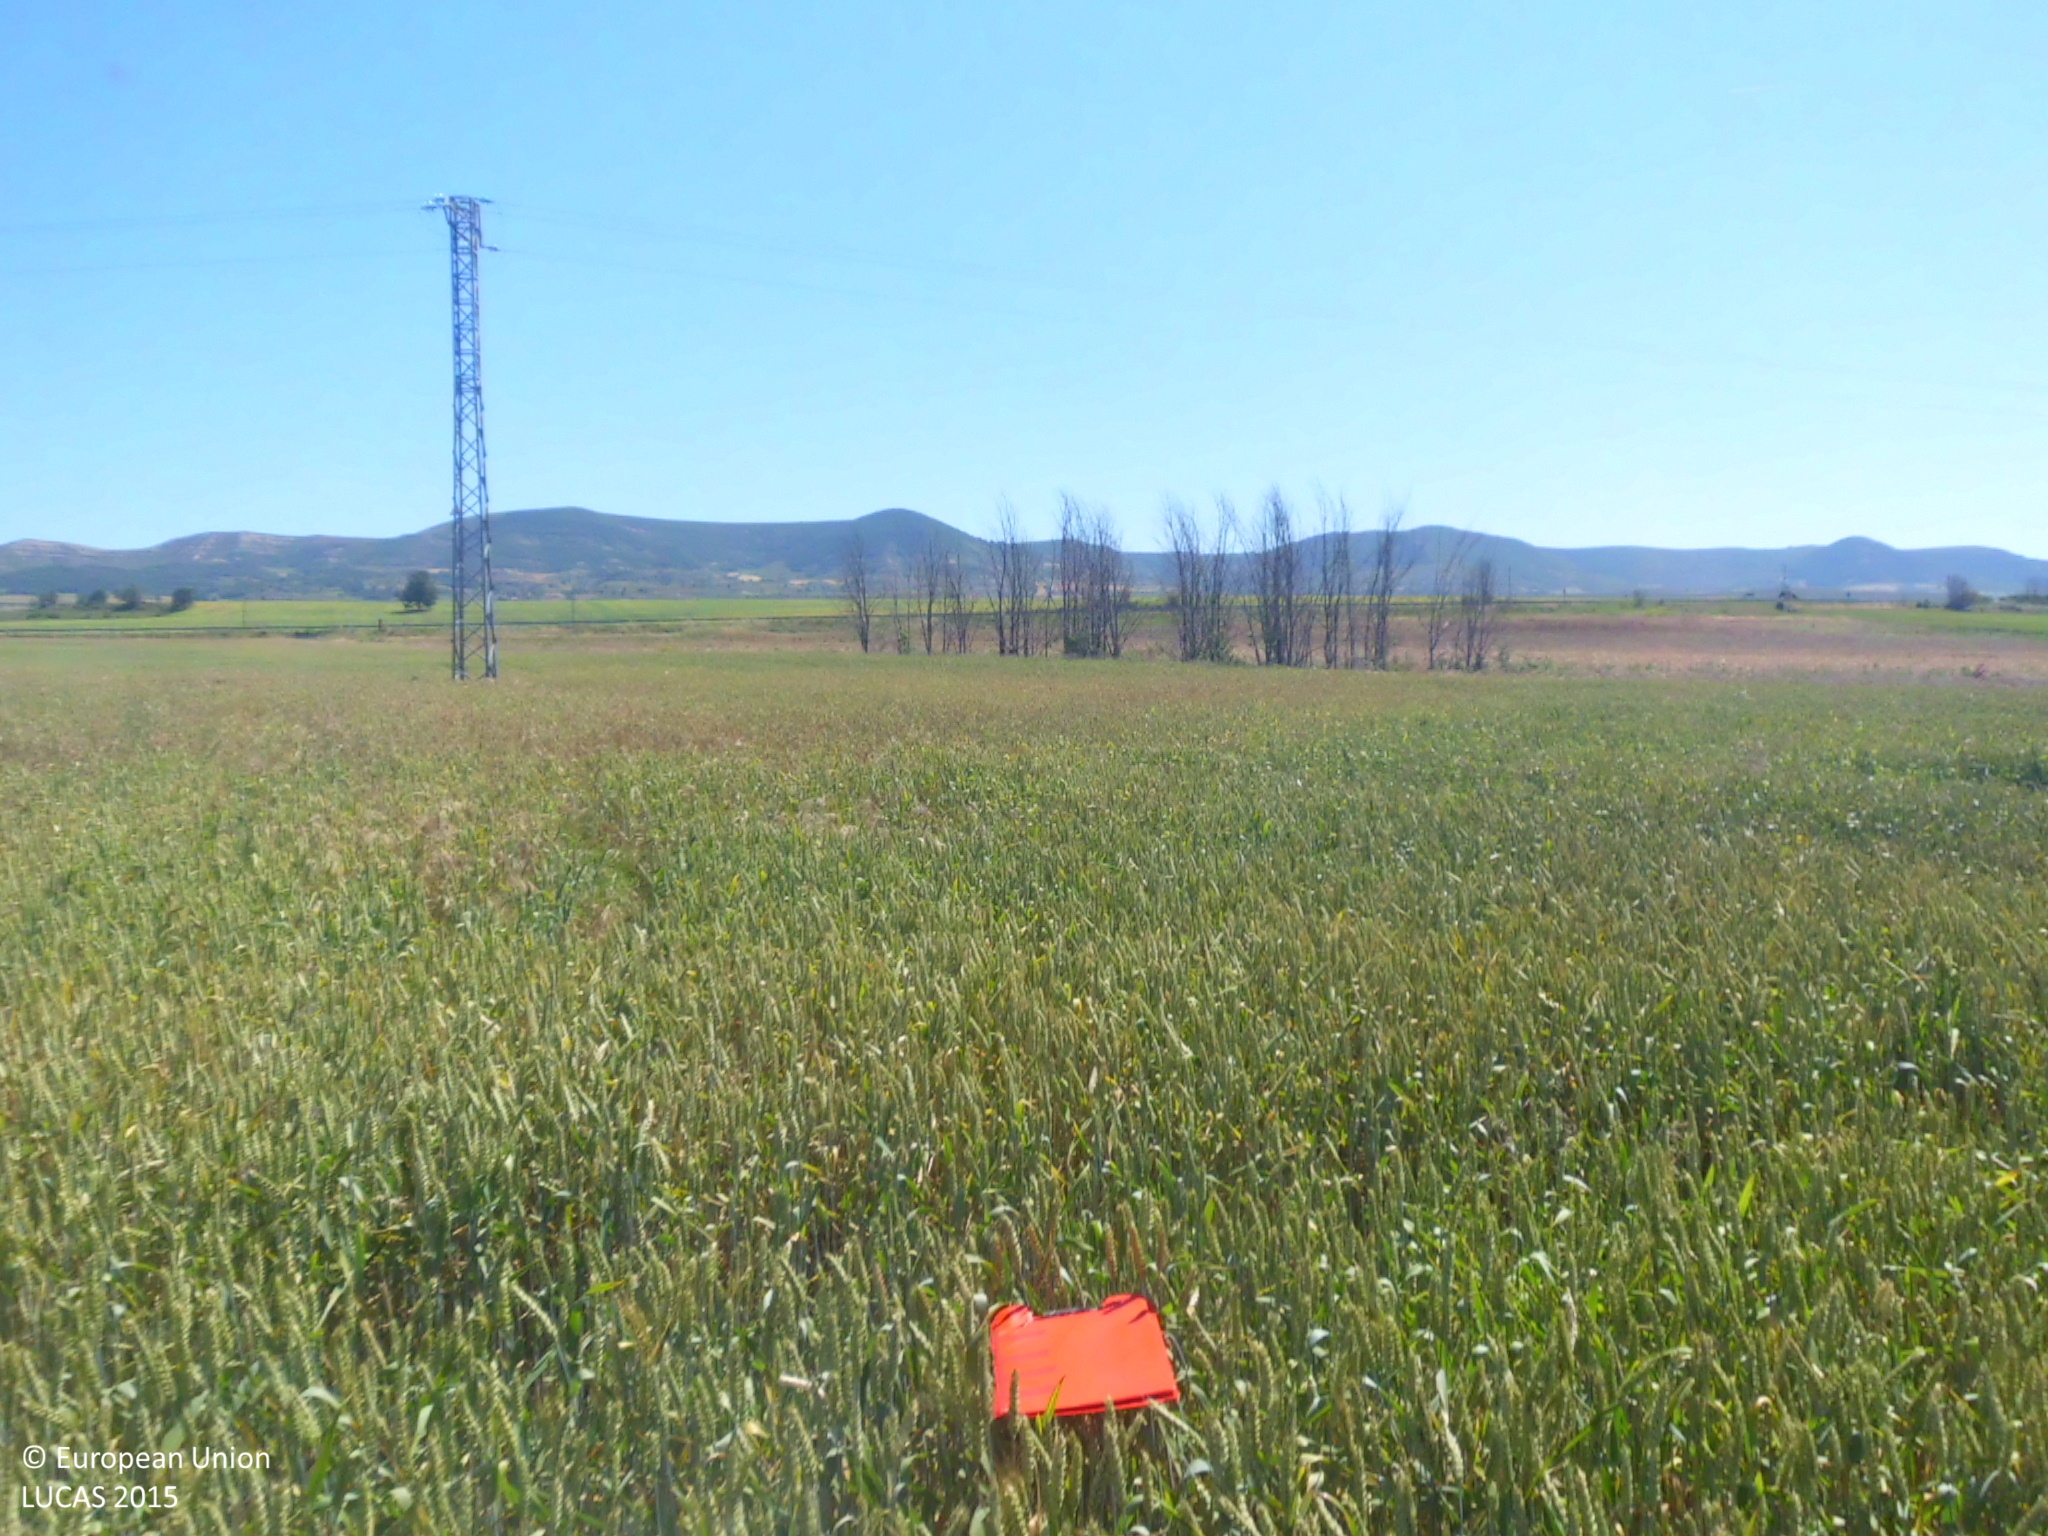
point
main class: Cropland
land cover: Common wheat
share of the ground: > 75 %
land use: Agriculture (excluding fallow land and kitchen gardens)
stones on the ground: < 10 %
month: June
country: ES
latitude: 42.9008
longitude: -3.4735
